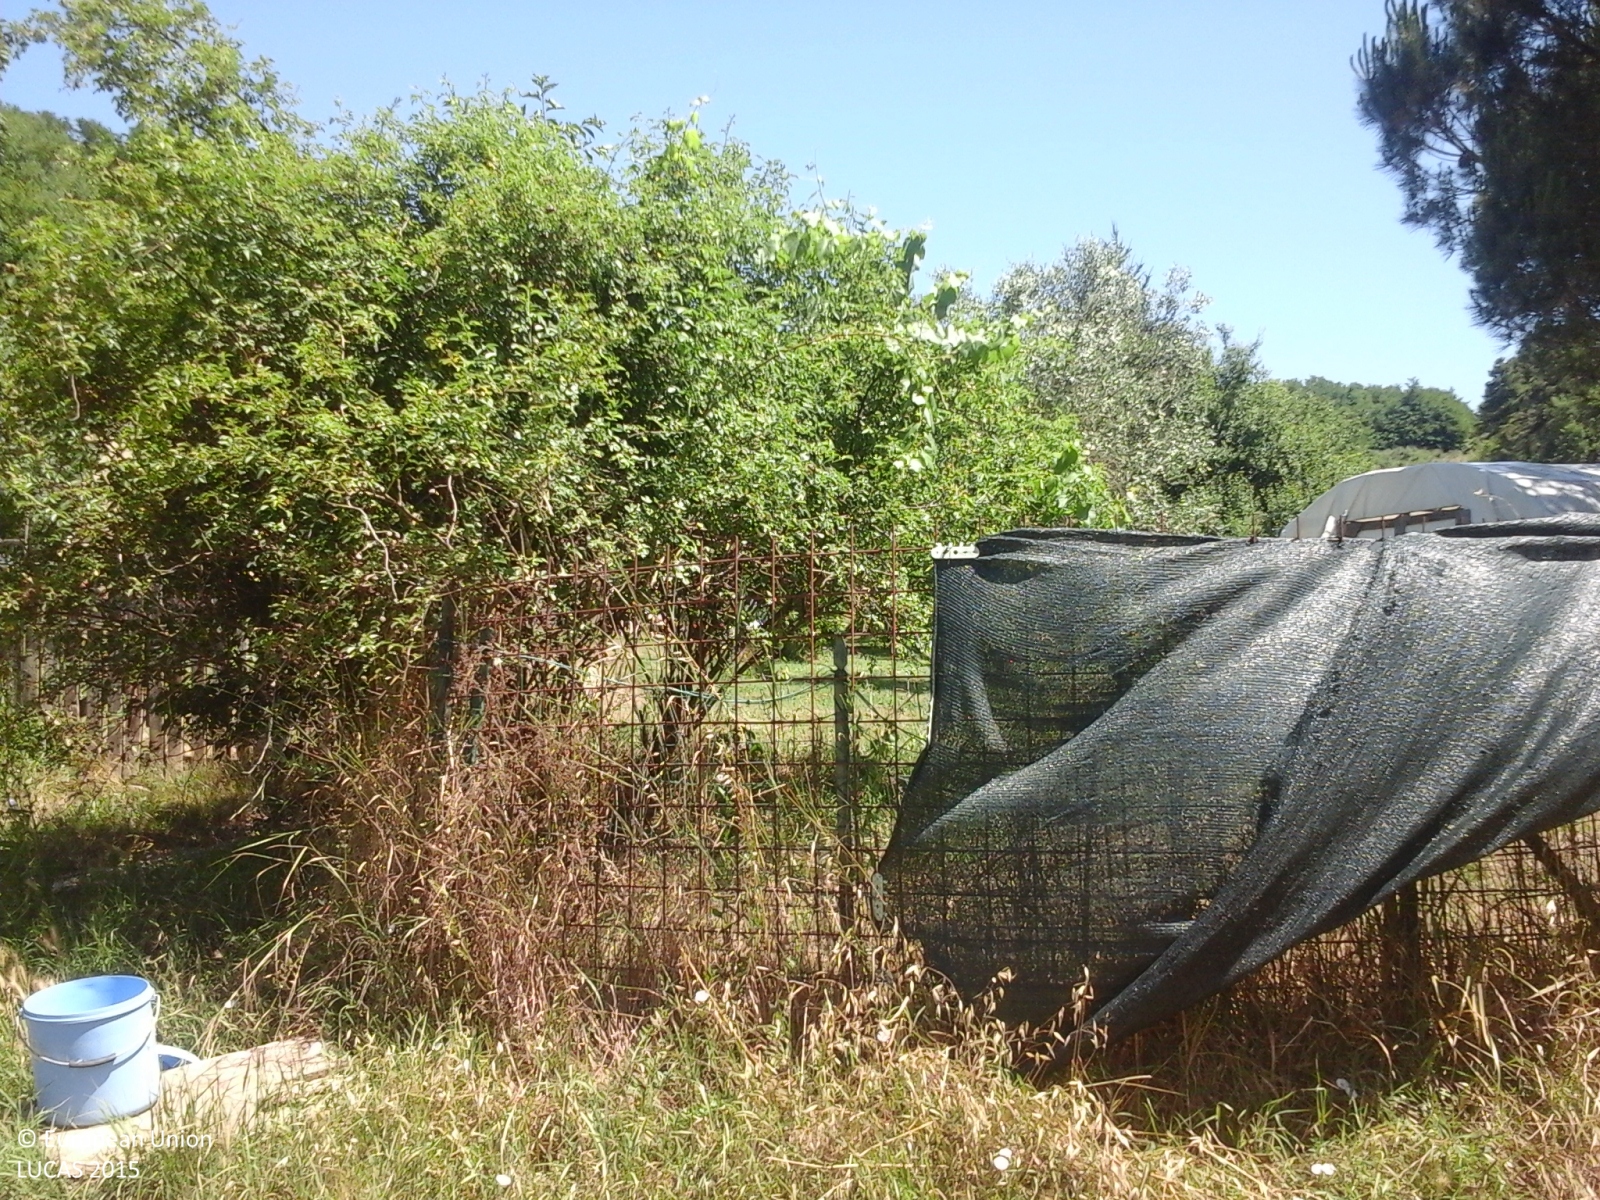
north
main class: Cropland
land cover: Olive groves
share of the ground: 50 - 75 %
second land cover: Grassland without tree/shrub cover
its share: 50 - 75 %
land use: Agriculture (excluding fallow land and kitchen gardens)
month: June
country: IT
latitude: 43.5730
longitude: 10.6051
